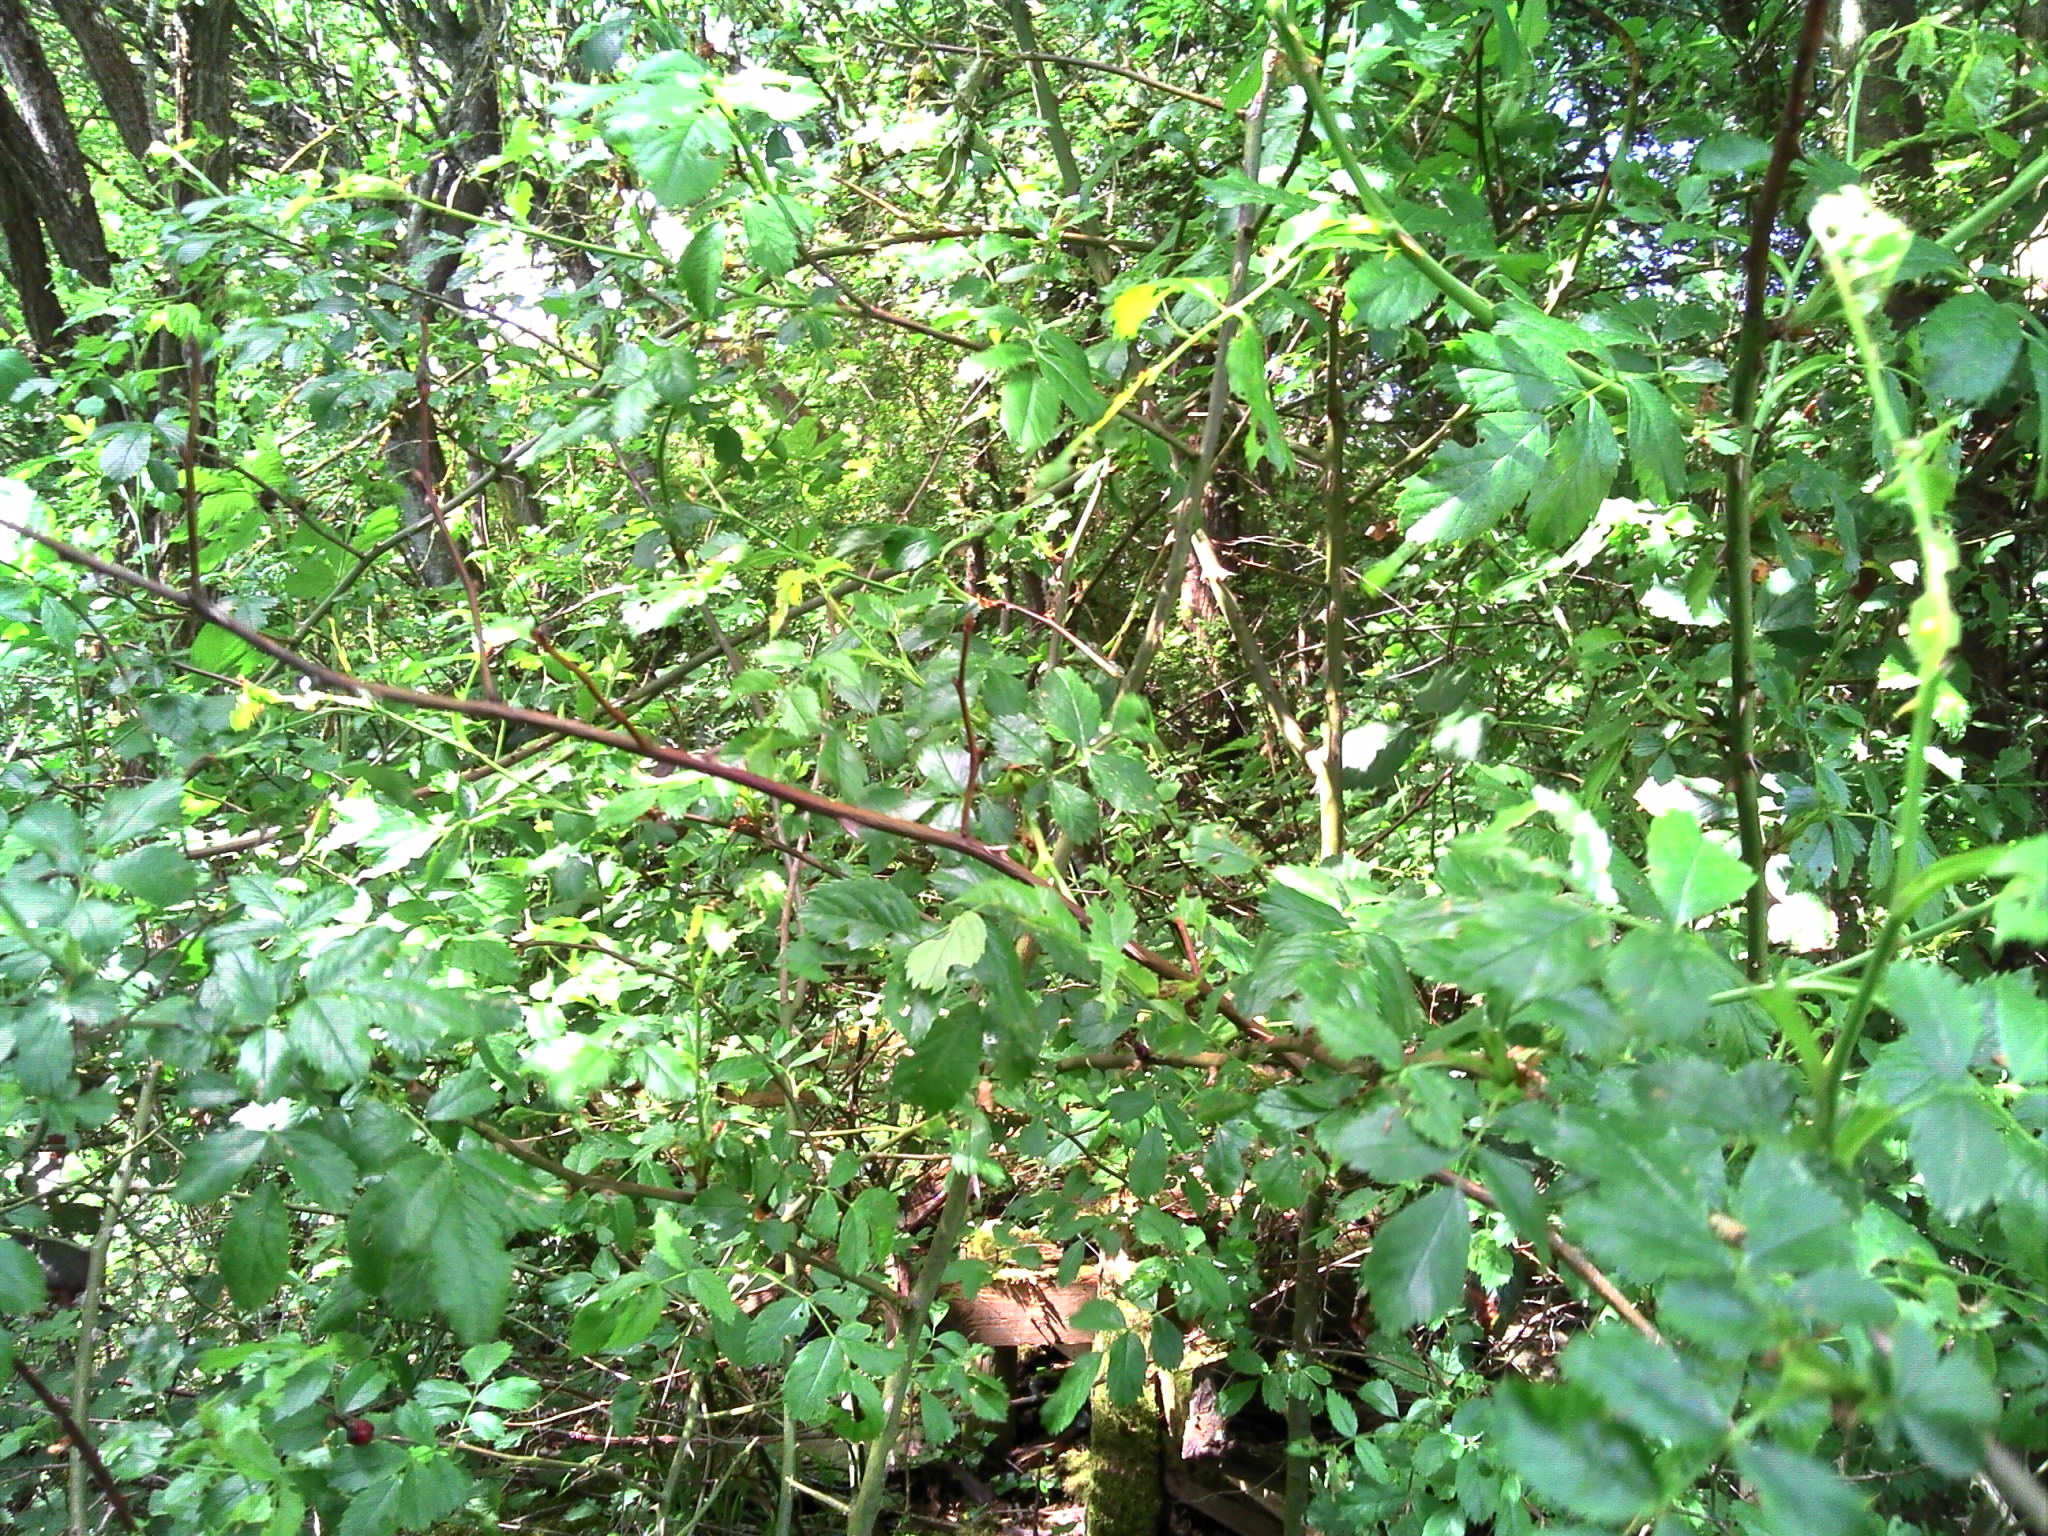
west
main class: Woodland
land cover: Broadleaved woodland
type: mesophytic deciduous forest
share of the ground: > 75 %
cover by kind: broadleaved forest trees 80 %, shrubs 20 %
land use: Semi-natural and natural areas not in use
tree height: > 5 m
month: May
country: LU
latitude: 49.7163
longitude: 6.4908
